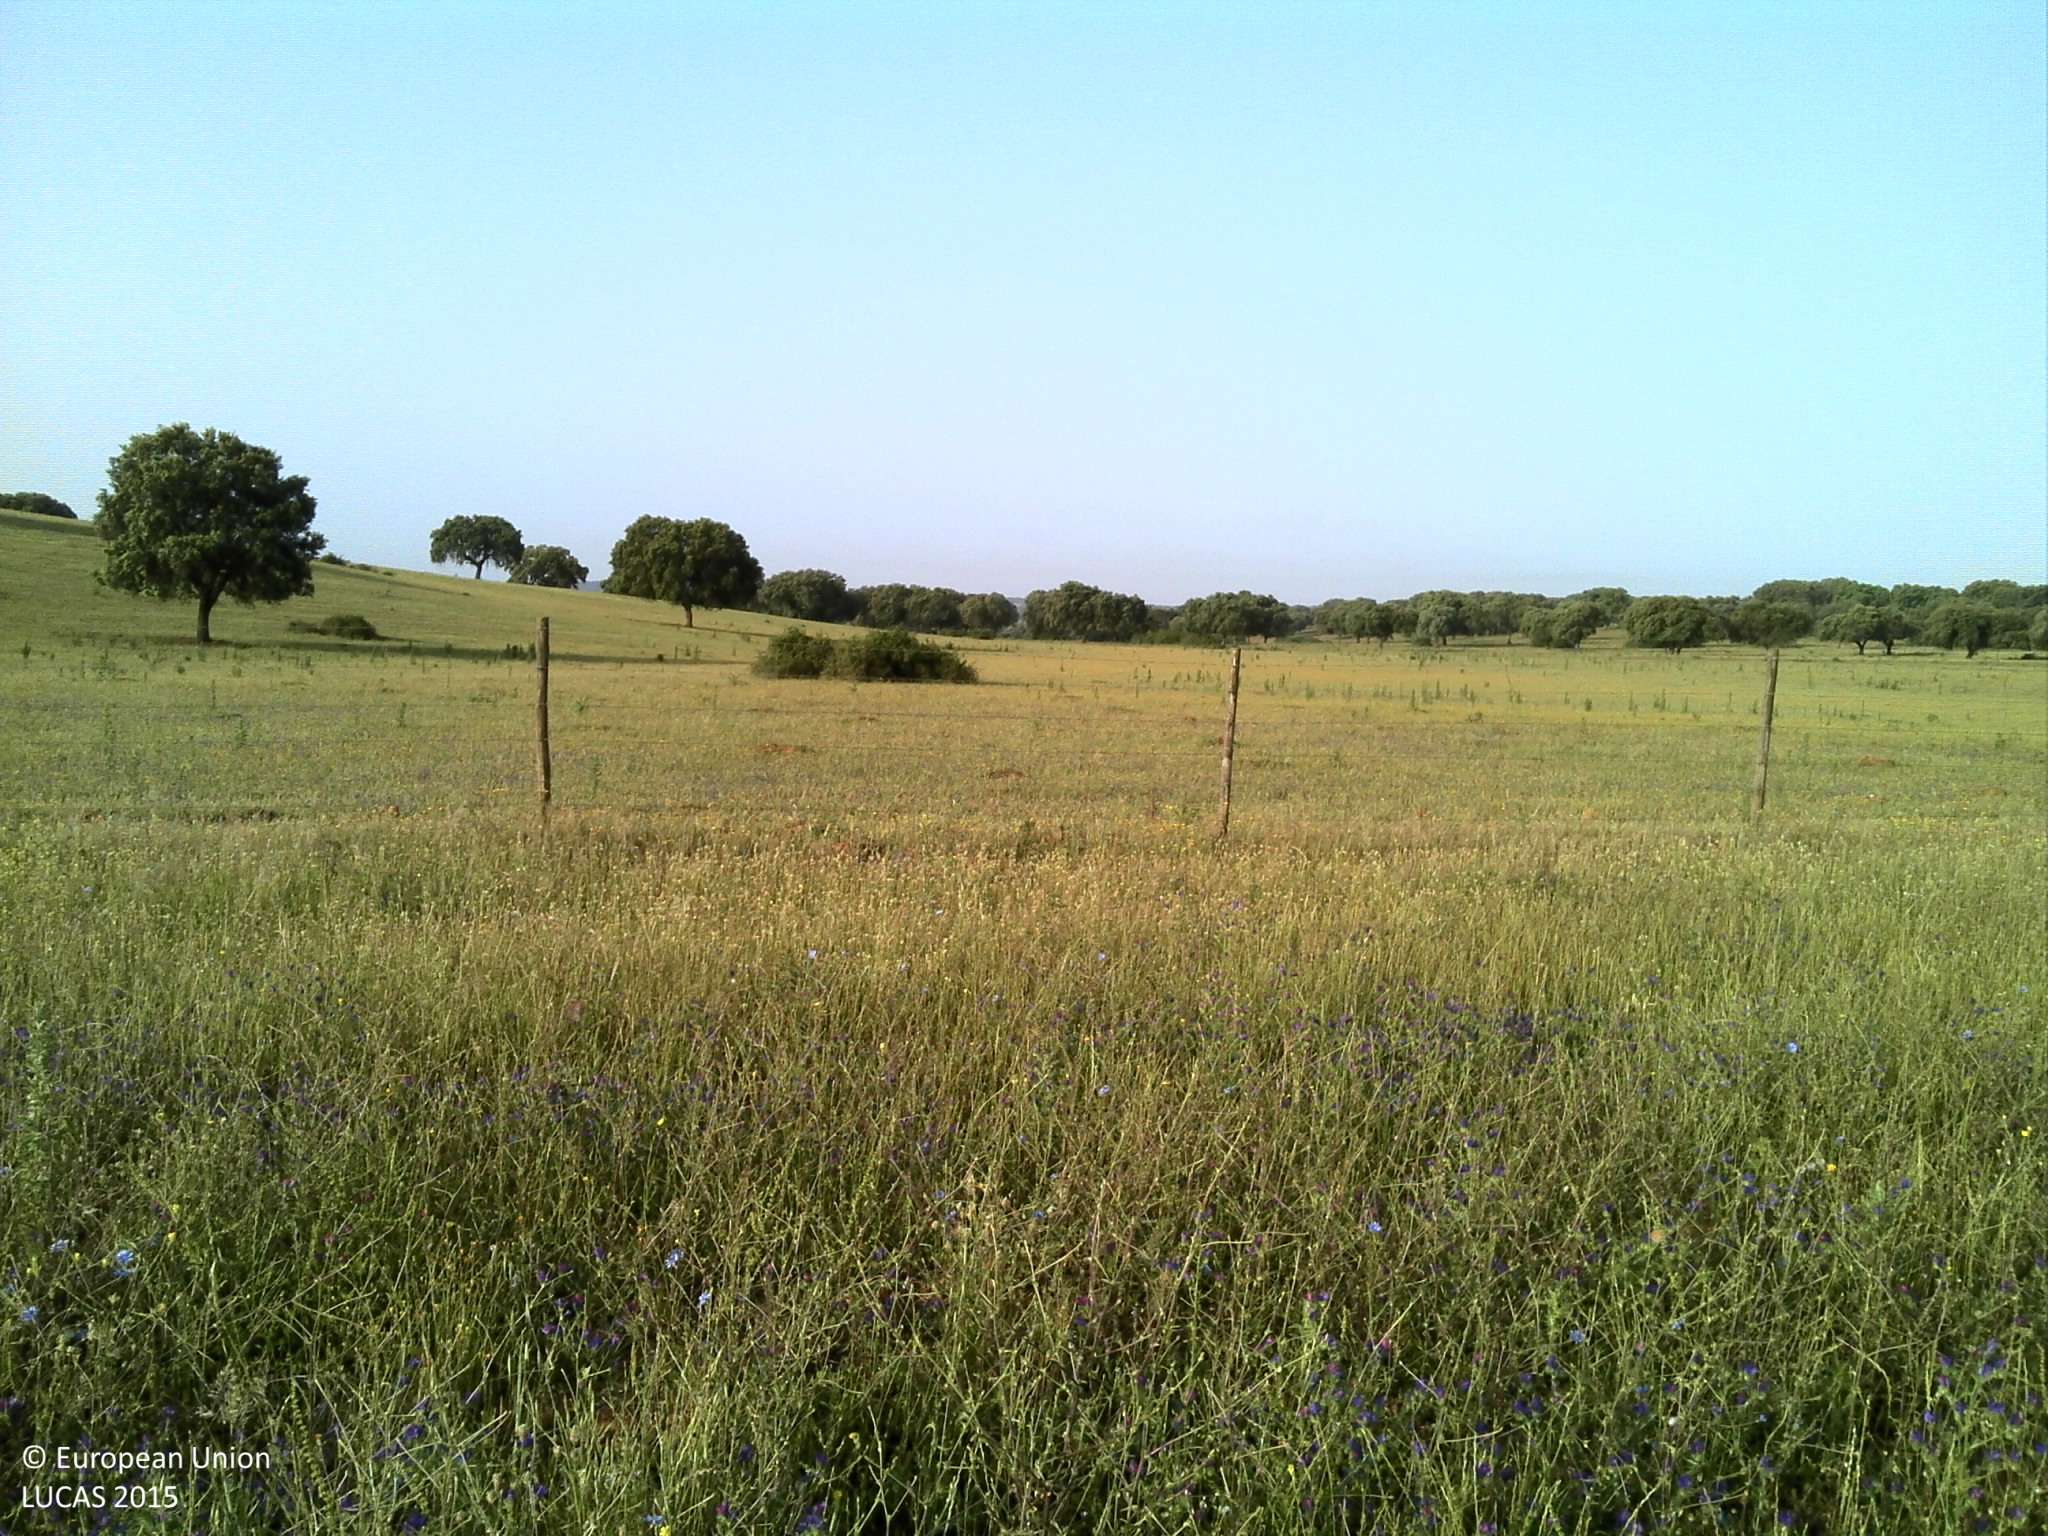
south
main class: Grassland
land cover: Grassland without tree/shrub cover
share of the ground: 50 - 75 %
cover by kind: herbaceous plants 75 %, unconsolidated bare surface 25 %
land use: Agriculture (excluding fallow land and kitchen gardens)
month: May
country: PT
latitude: 39.0360
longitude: -7.8730
